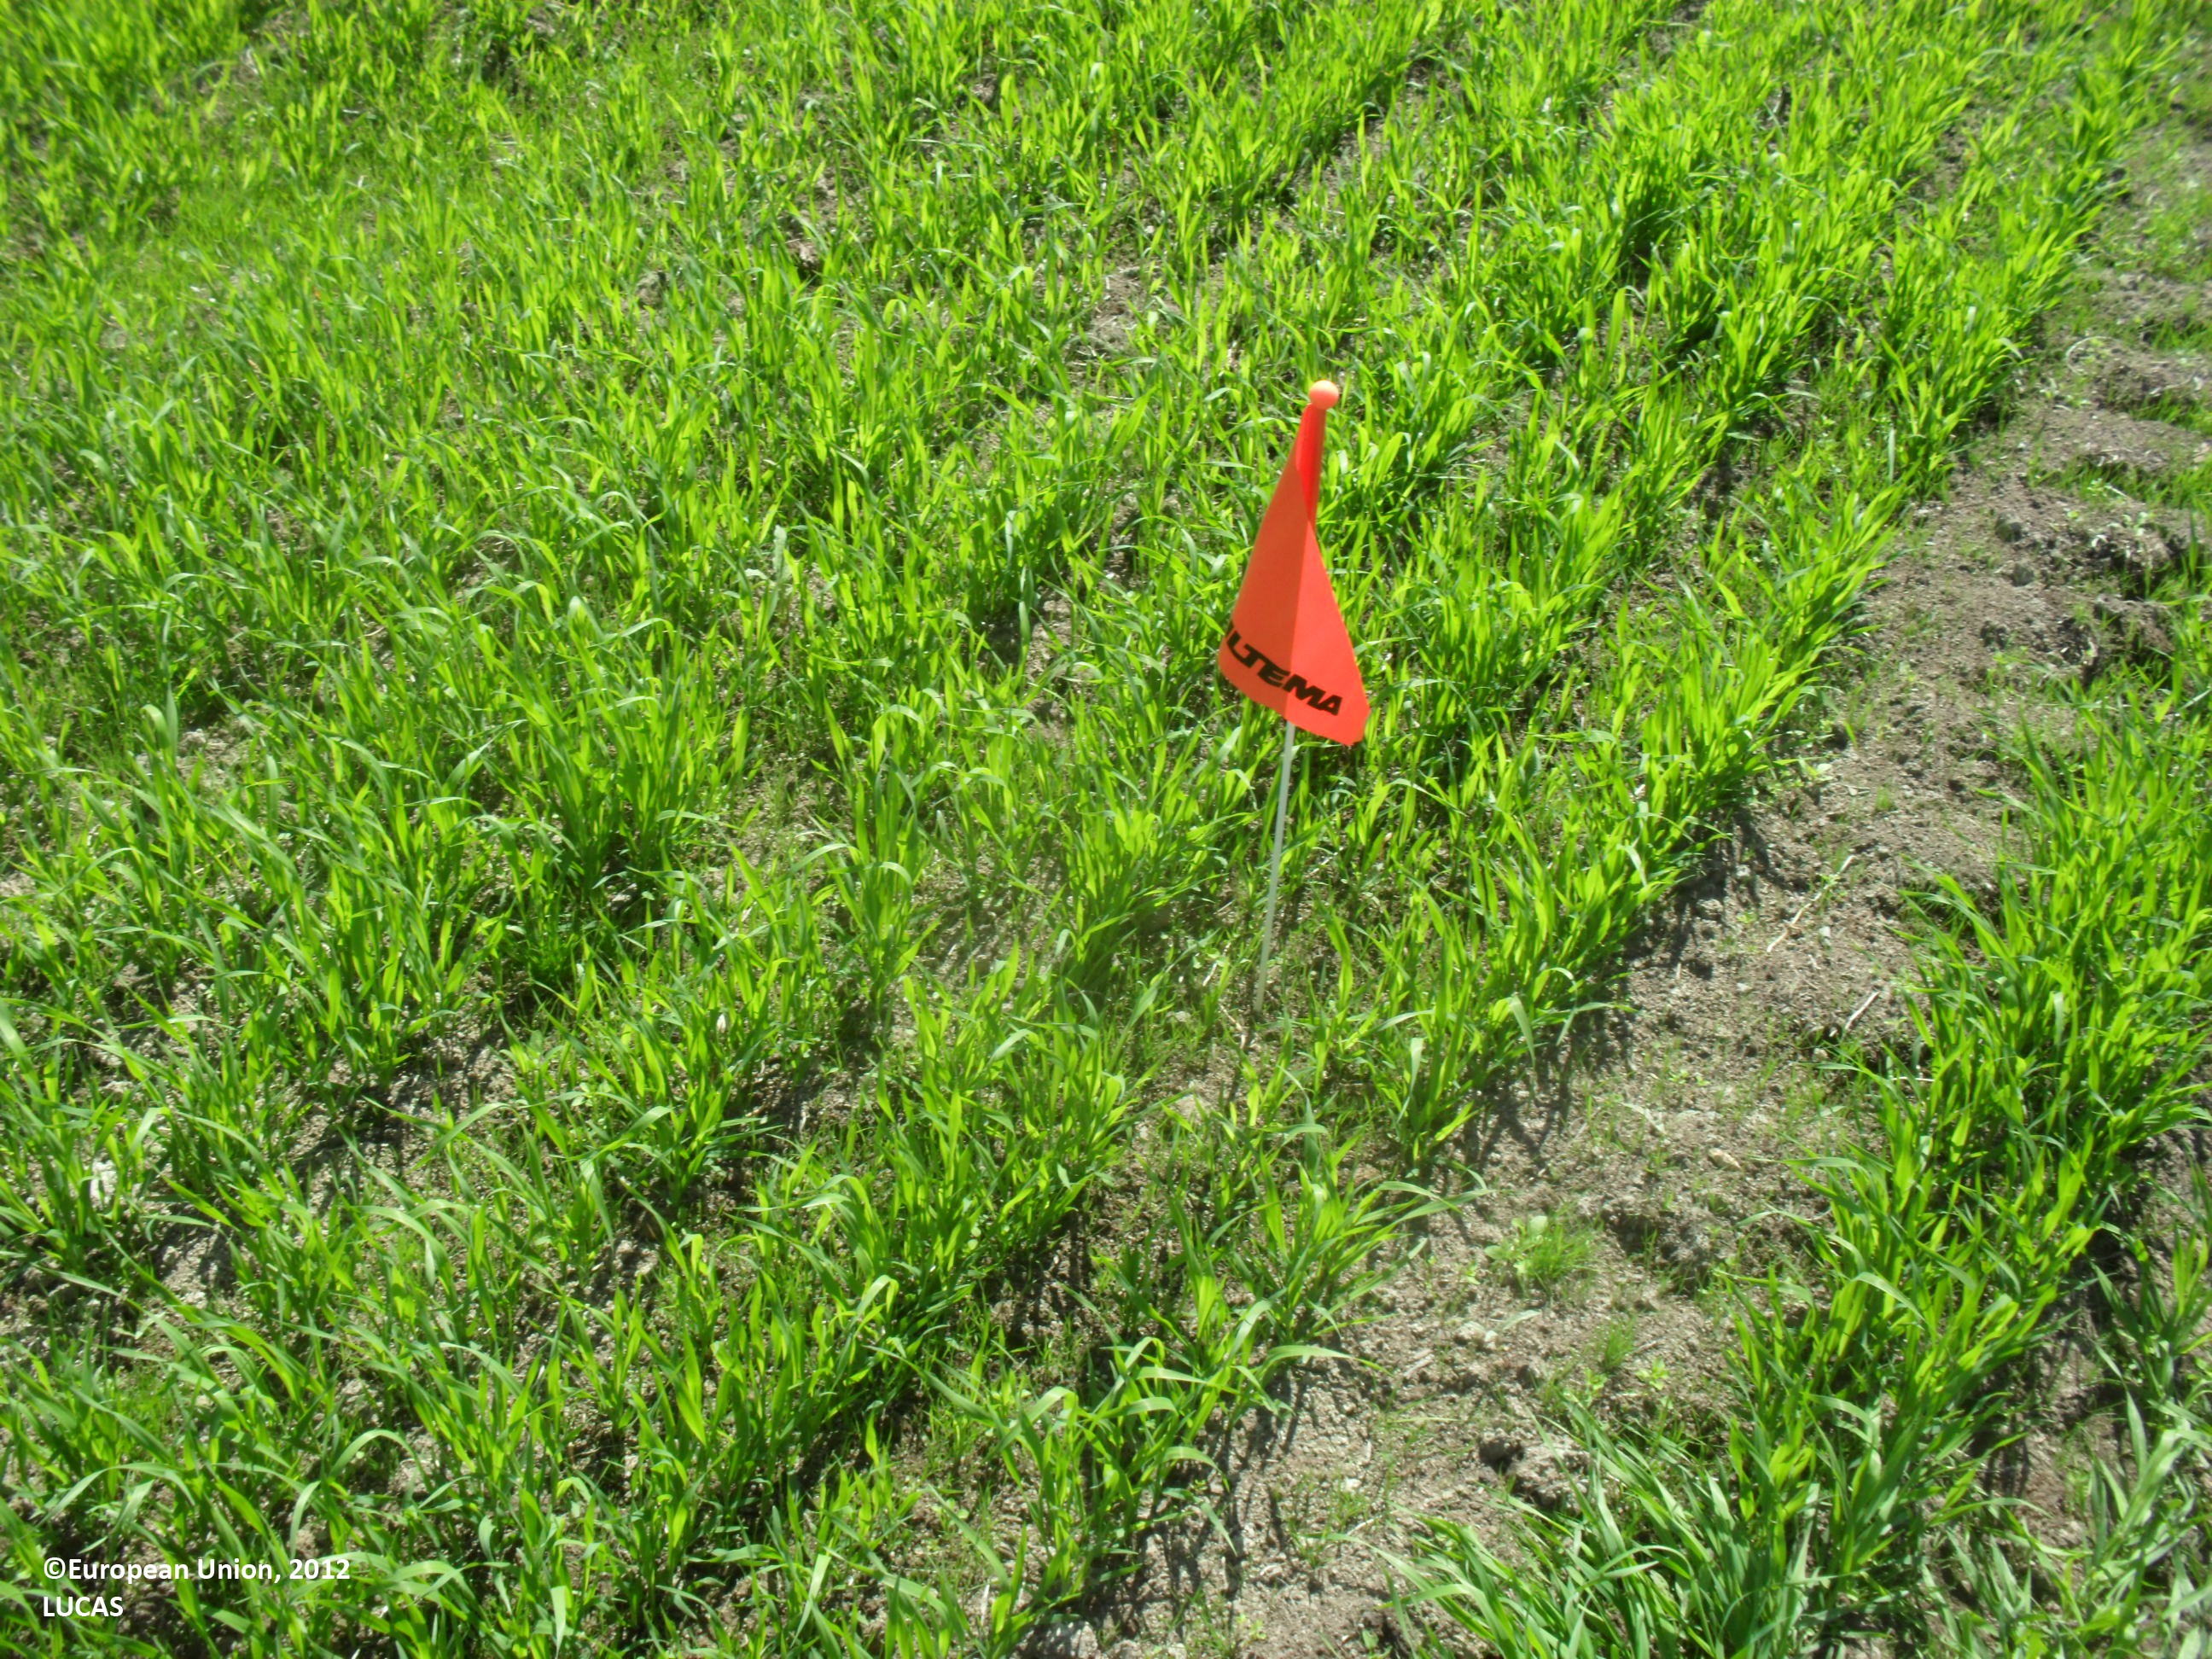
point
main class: Cropland
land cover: Oats
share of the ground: 50 - 75 %
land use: Agriculture (excluding fallow land and kitchen gardens)
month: June
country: FI
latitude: 63.2888
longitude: 23.0382
